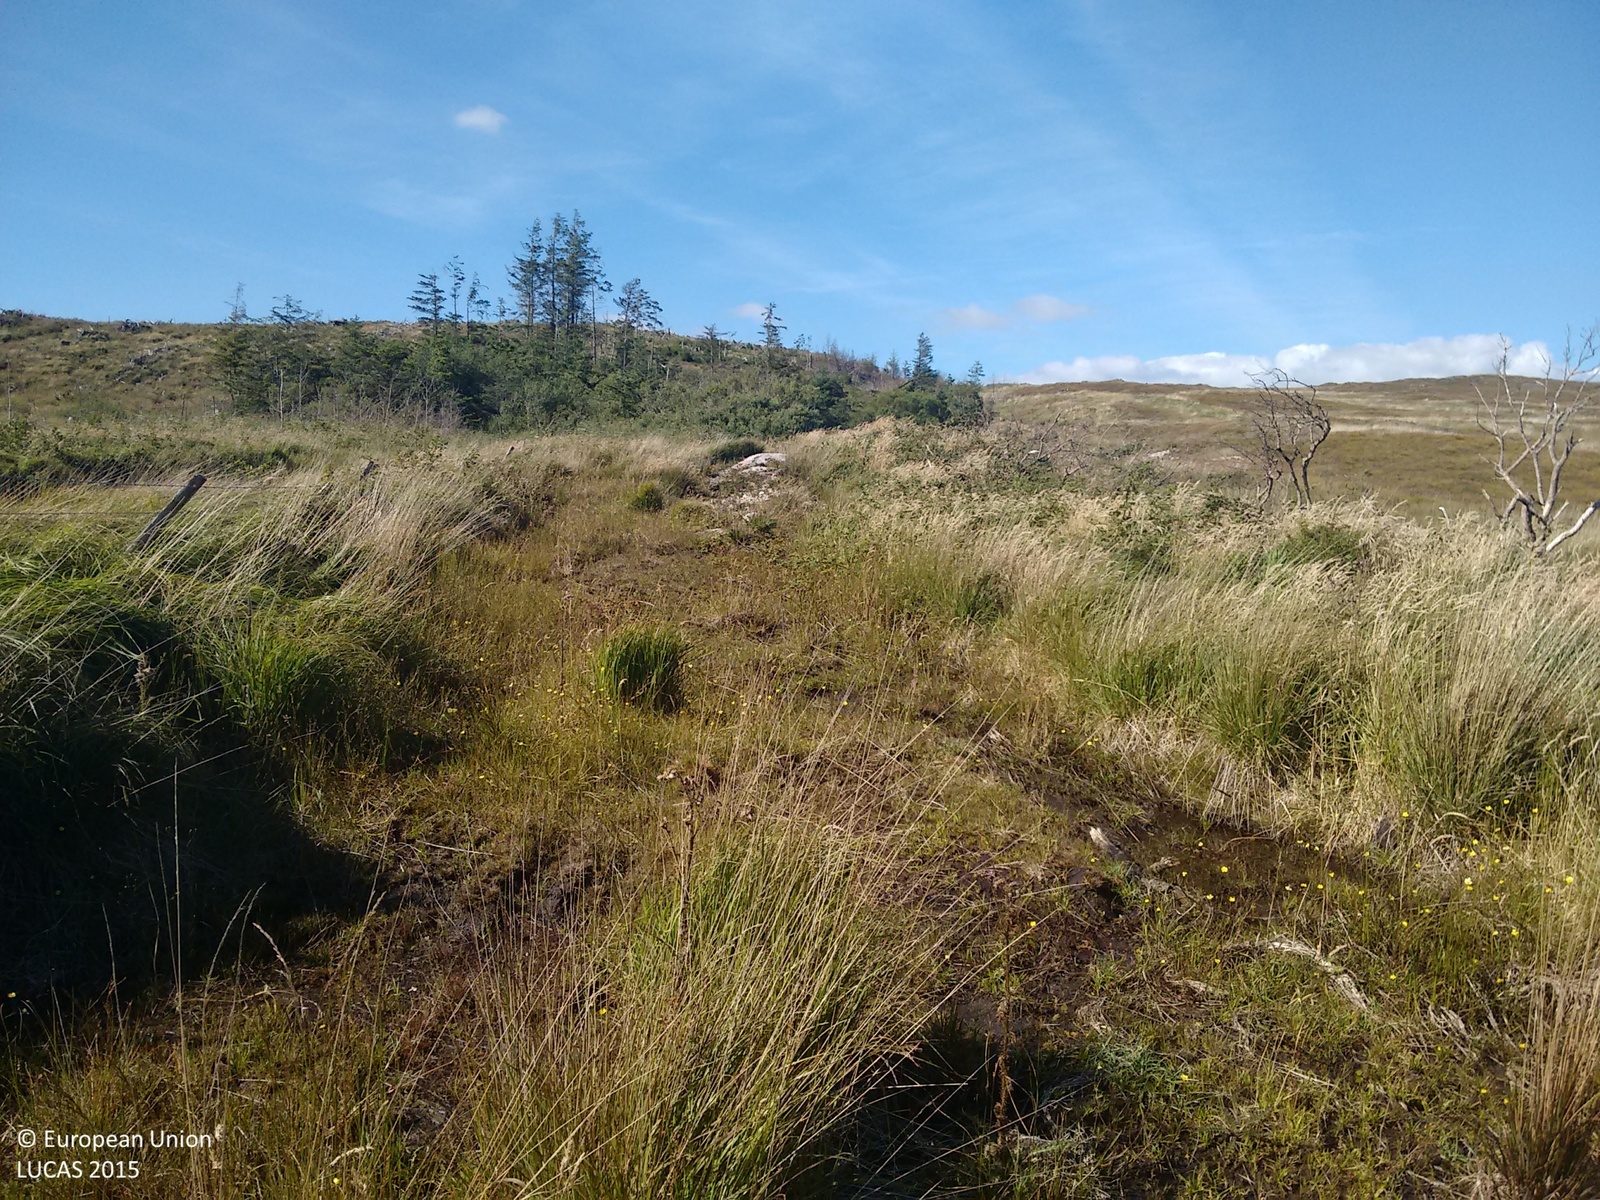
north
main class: Grassland
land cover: Spontaneously vegetated surfaces
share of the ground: > 75 %
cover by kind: herbaceous plants 70 %, unconsolidated bare surface 30 %
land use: Semi-natural and natural areas not in use
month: August
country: IE
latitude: 51.6199
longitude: -9.4251
